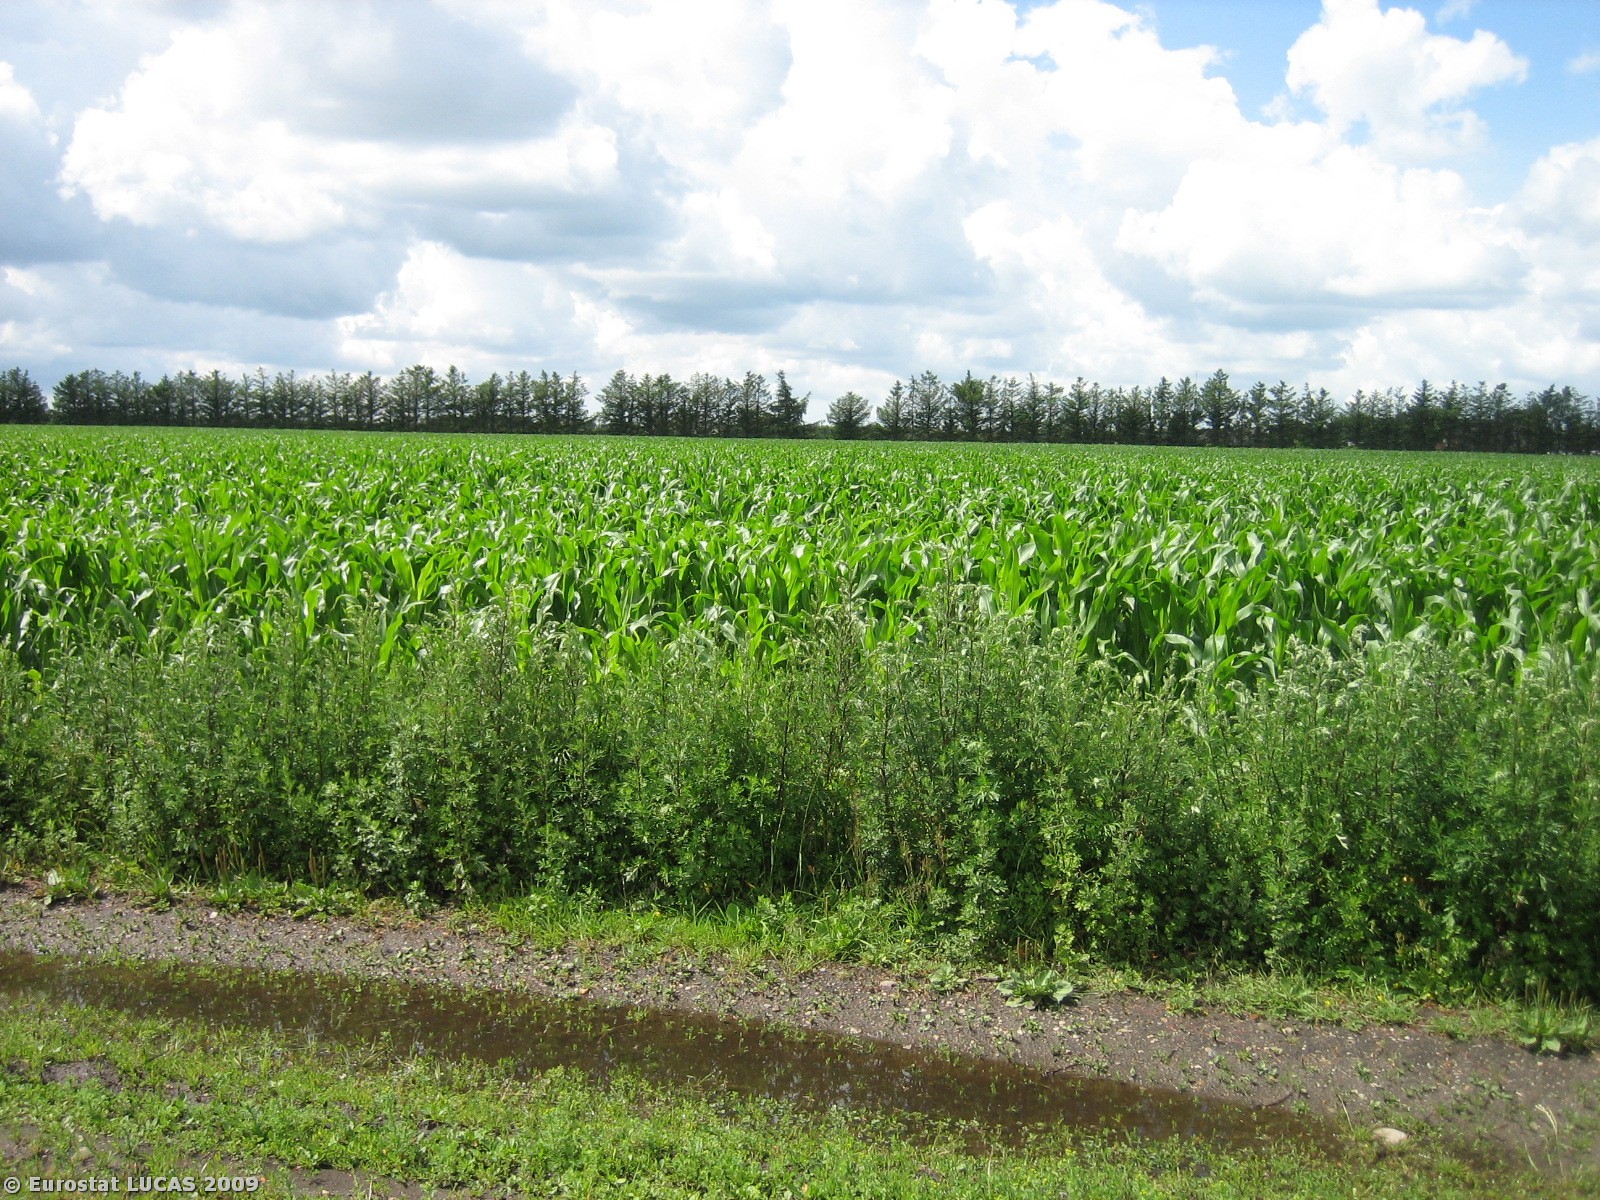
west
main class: Cropland
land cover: Maize
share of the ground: 25 - 50 %
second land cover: Spontaneously vegetated surfaces
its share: > 75 %
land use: Agriculture (excluding fallow land and kitchen gardens)
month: July
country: DK
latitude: 55.6426
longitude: 8.7778
